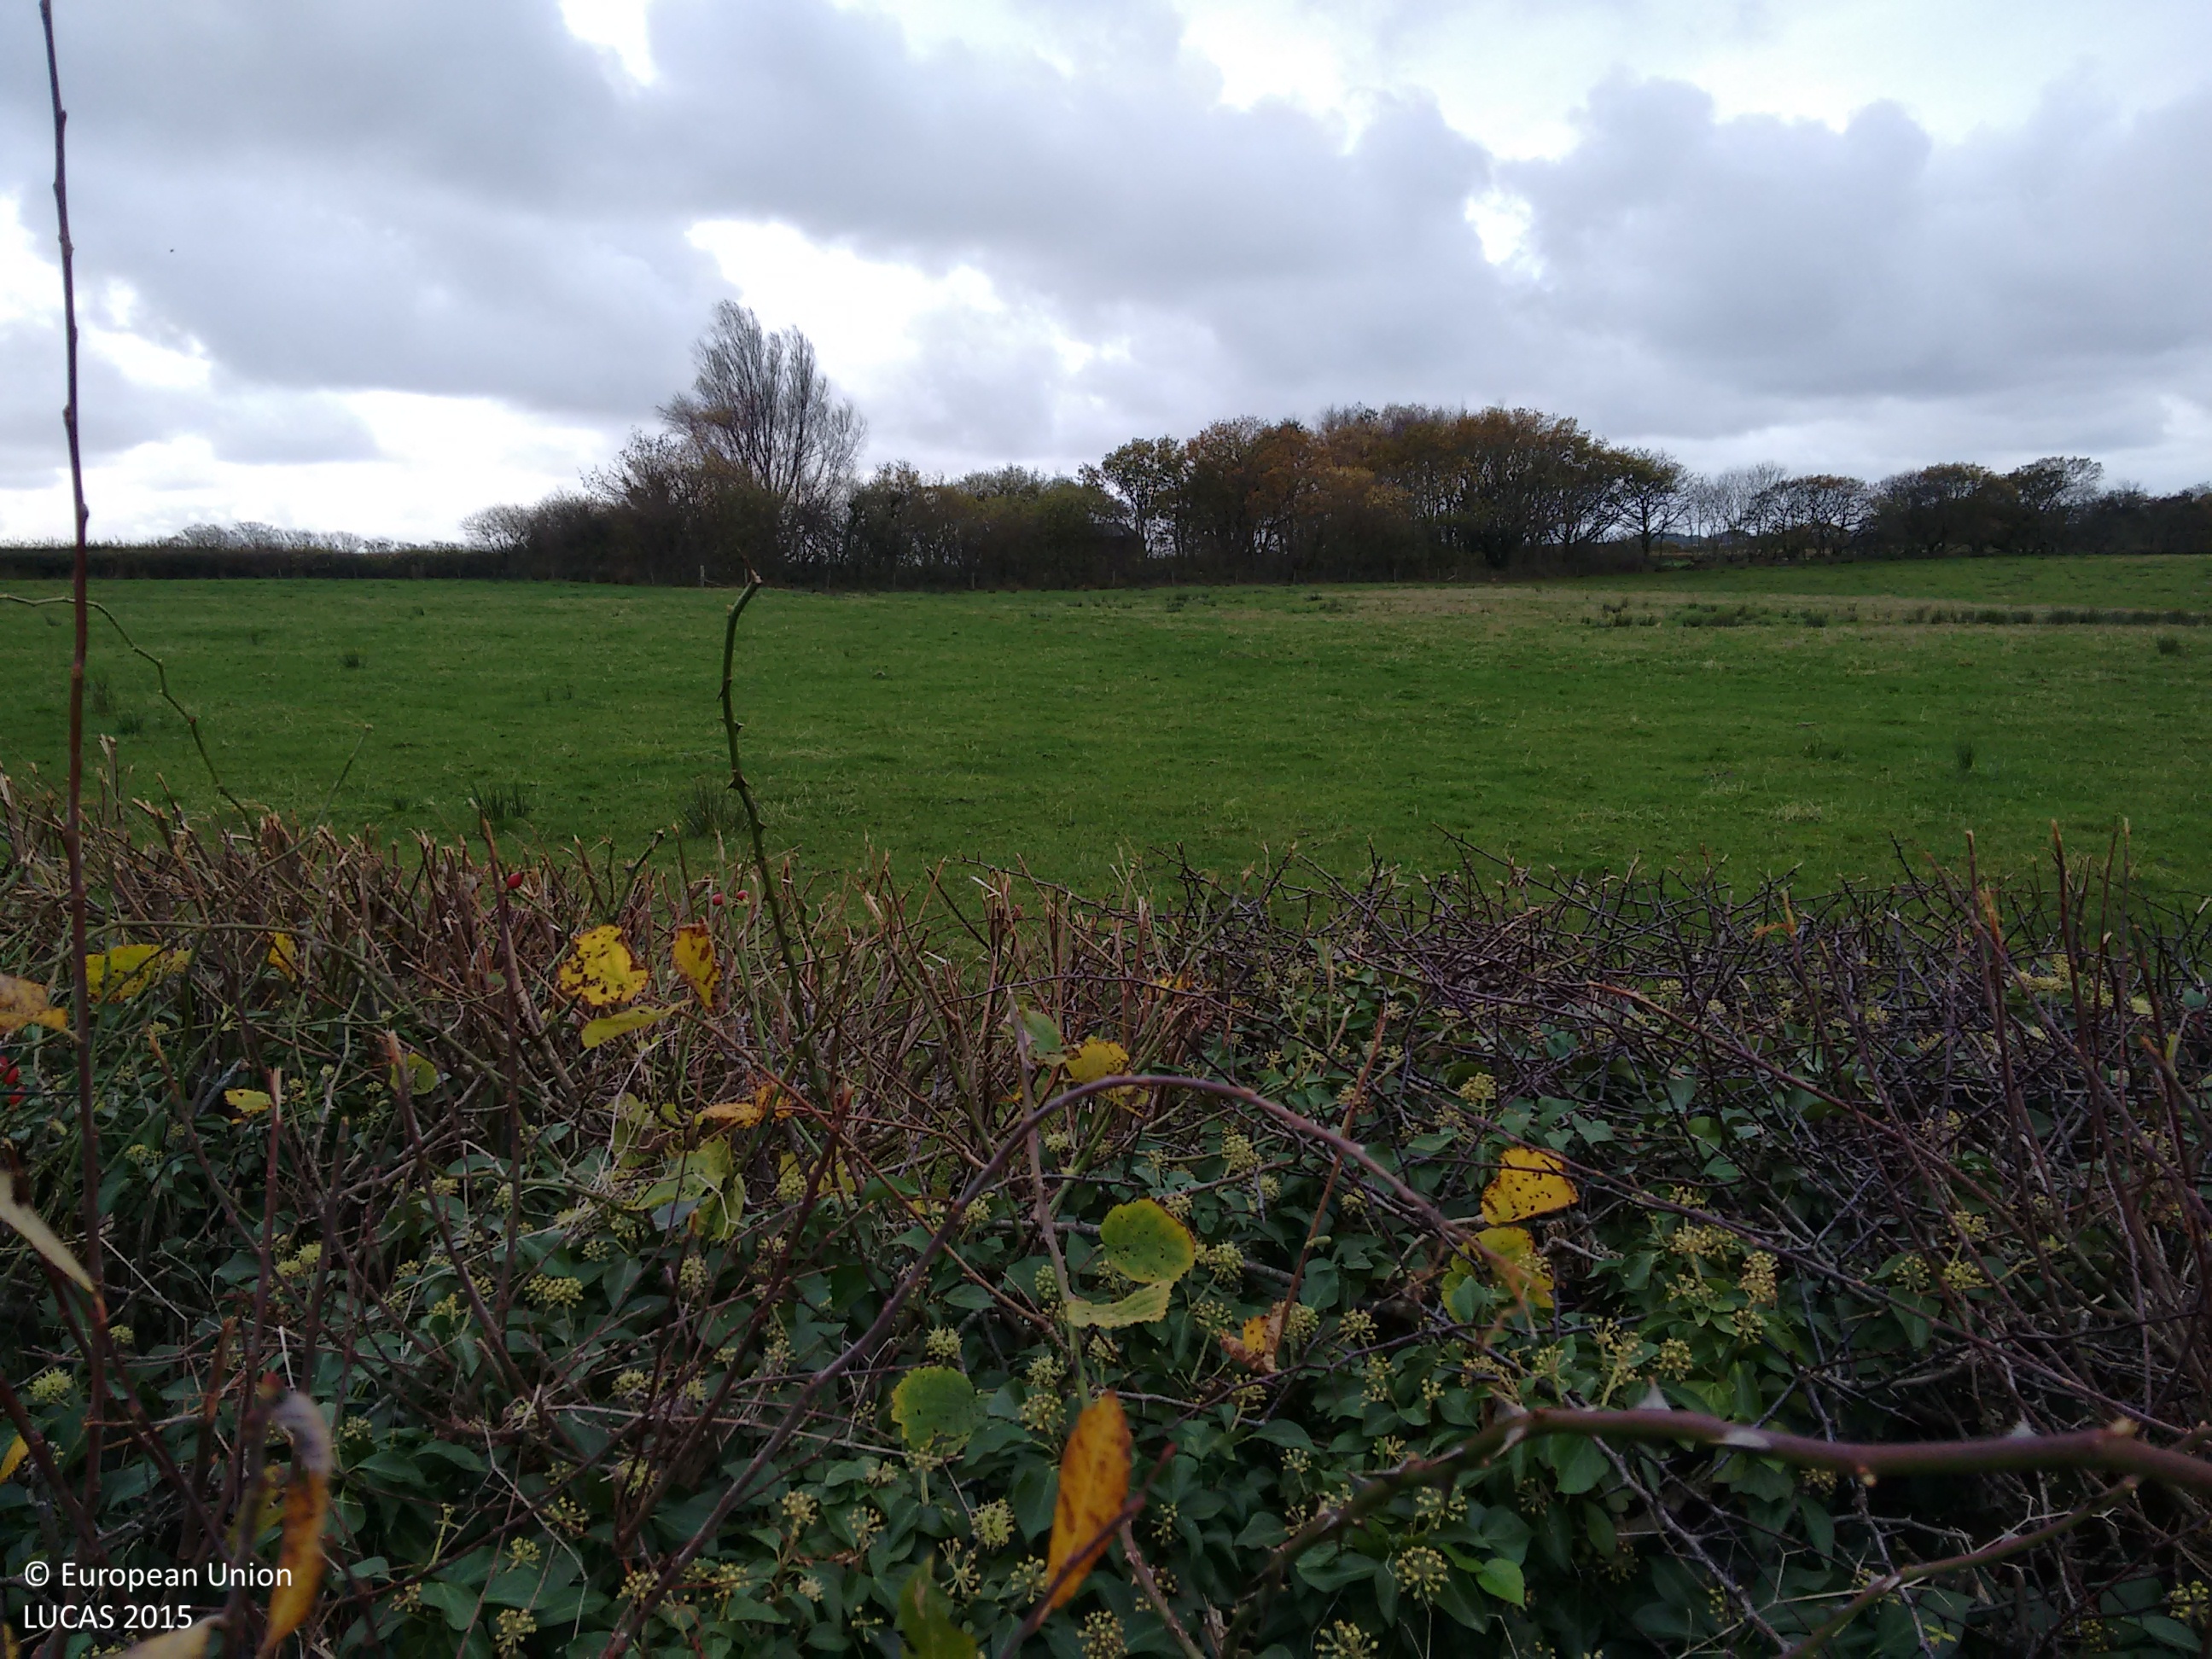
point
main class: Grassland
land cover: Grassland without tree/shrub cover
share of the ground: > 75 %
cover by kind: herbaceous plants 100 %
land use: Agriculture (excluding fallow land and kitchen gardens)
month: November
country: GB
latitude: 54.3329
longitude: -3.3825
